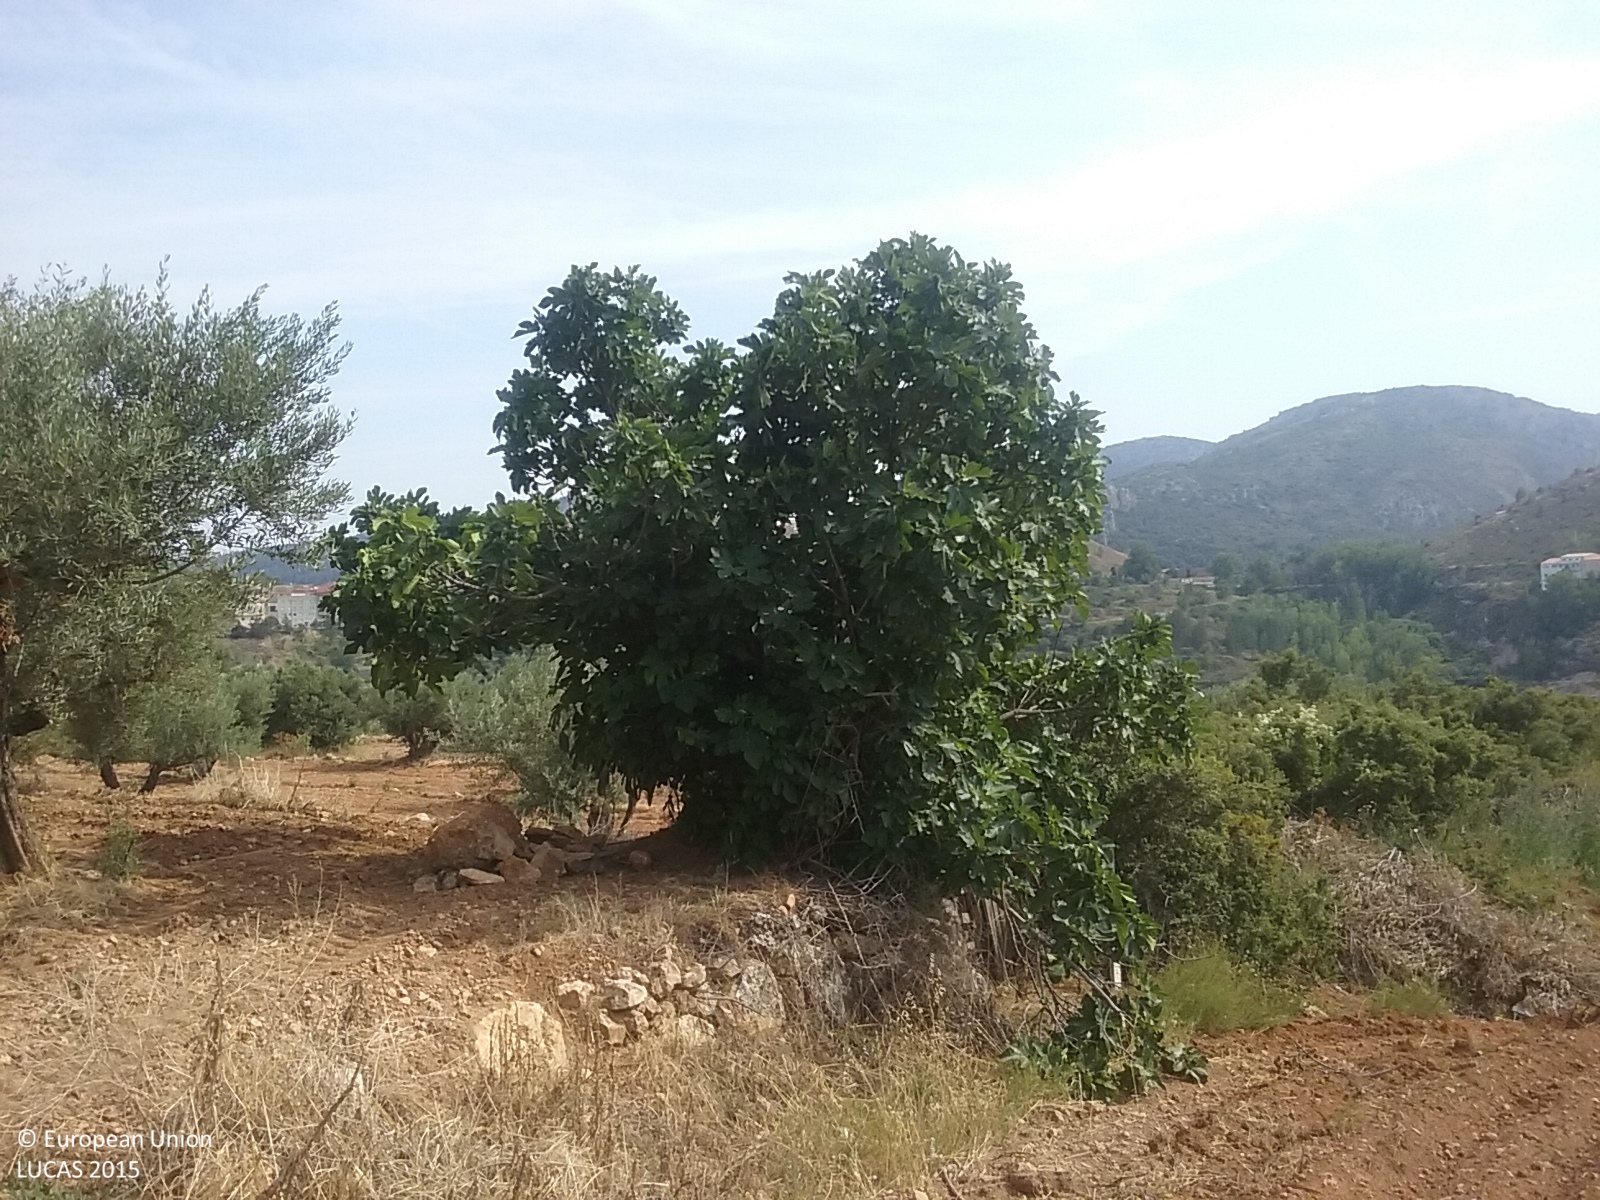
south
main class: Cropland
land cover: Nuts trees
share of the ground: 10 - 25 %
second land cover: Spontaneously vegetated surfaces
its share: 10 - 25 %
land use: Agriculture (excluding fallow land and kitchen gardens)
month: July
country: ES
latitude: 39.9166
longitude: -0.7083
